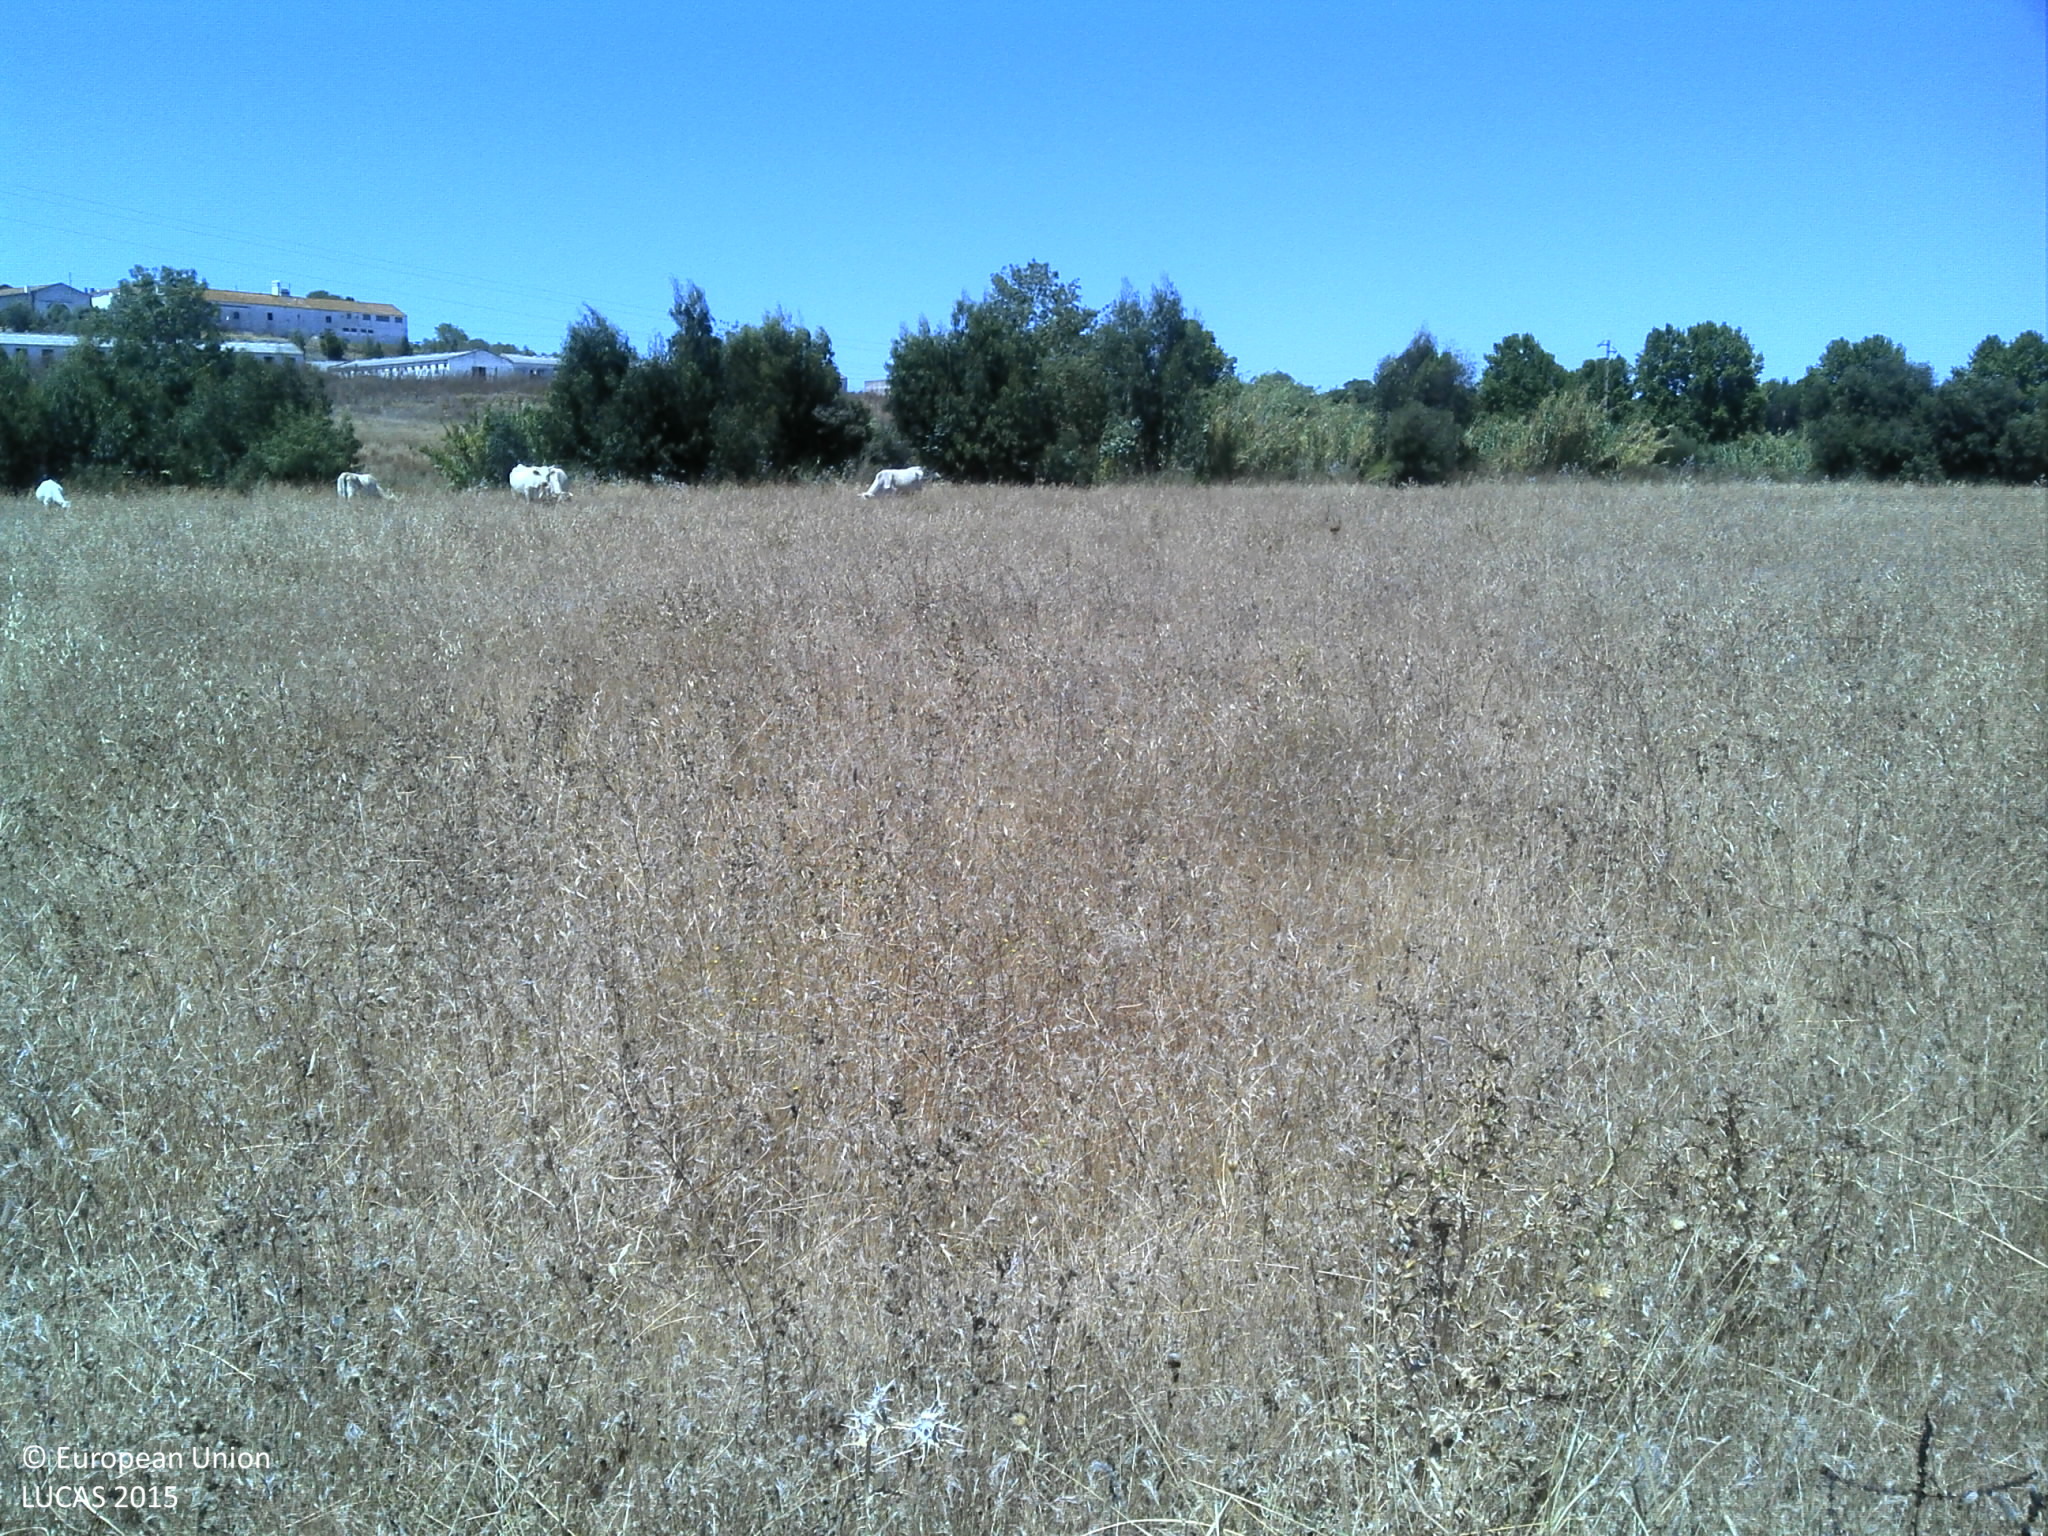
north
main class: Grassland
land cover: Grassland without tree/shrub cover
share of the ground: > 75 %
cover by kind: herbaceous plants 90 %, unconsolidated bare surface 10 %
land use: Agriculture (excluding fallow land and kitchen gardens)
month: July
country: PT
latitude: 38.0374
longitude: -8.0693
